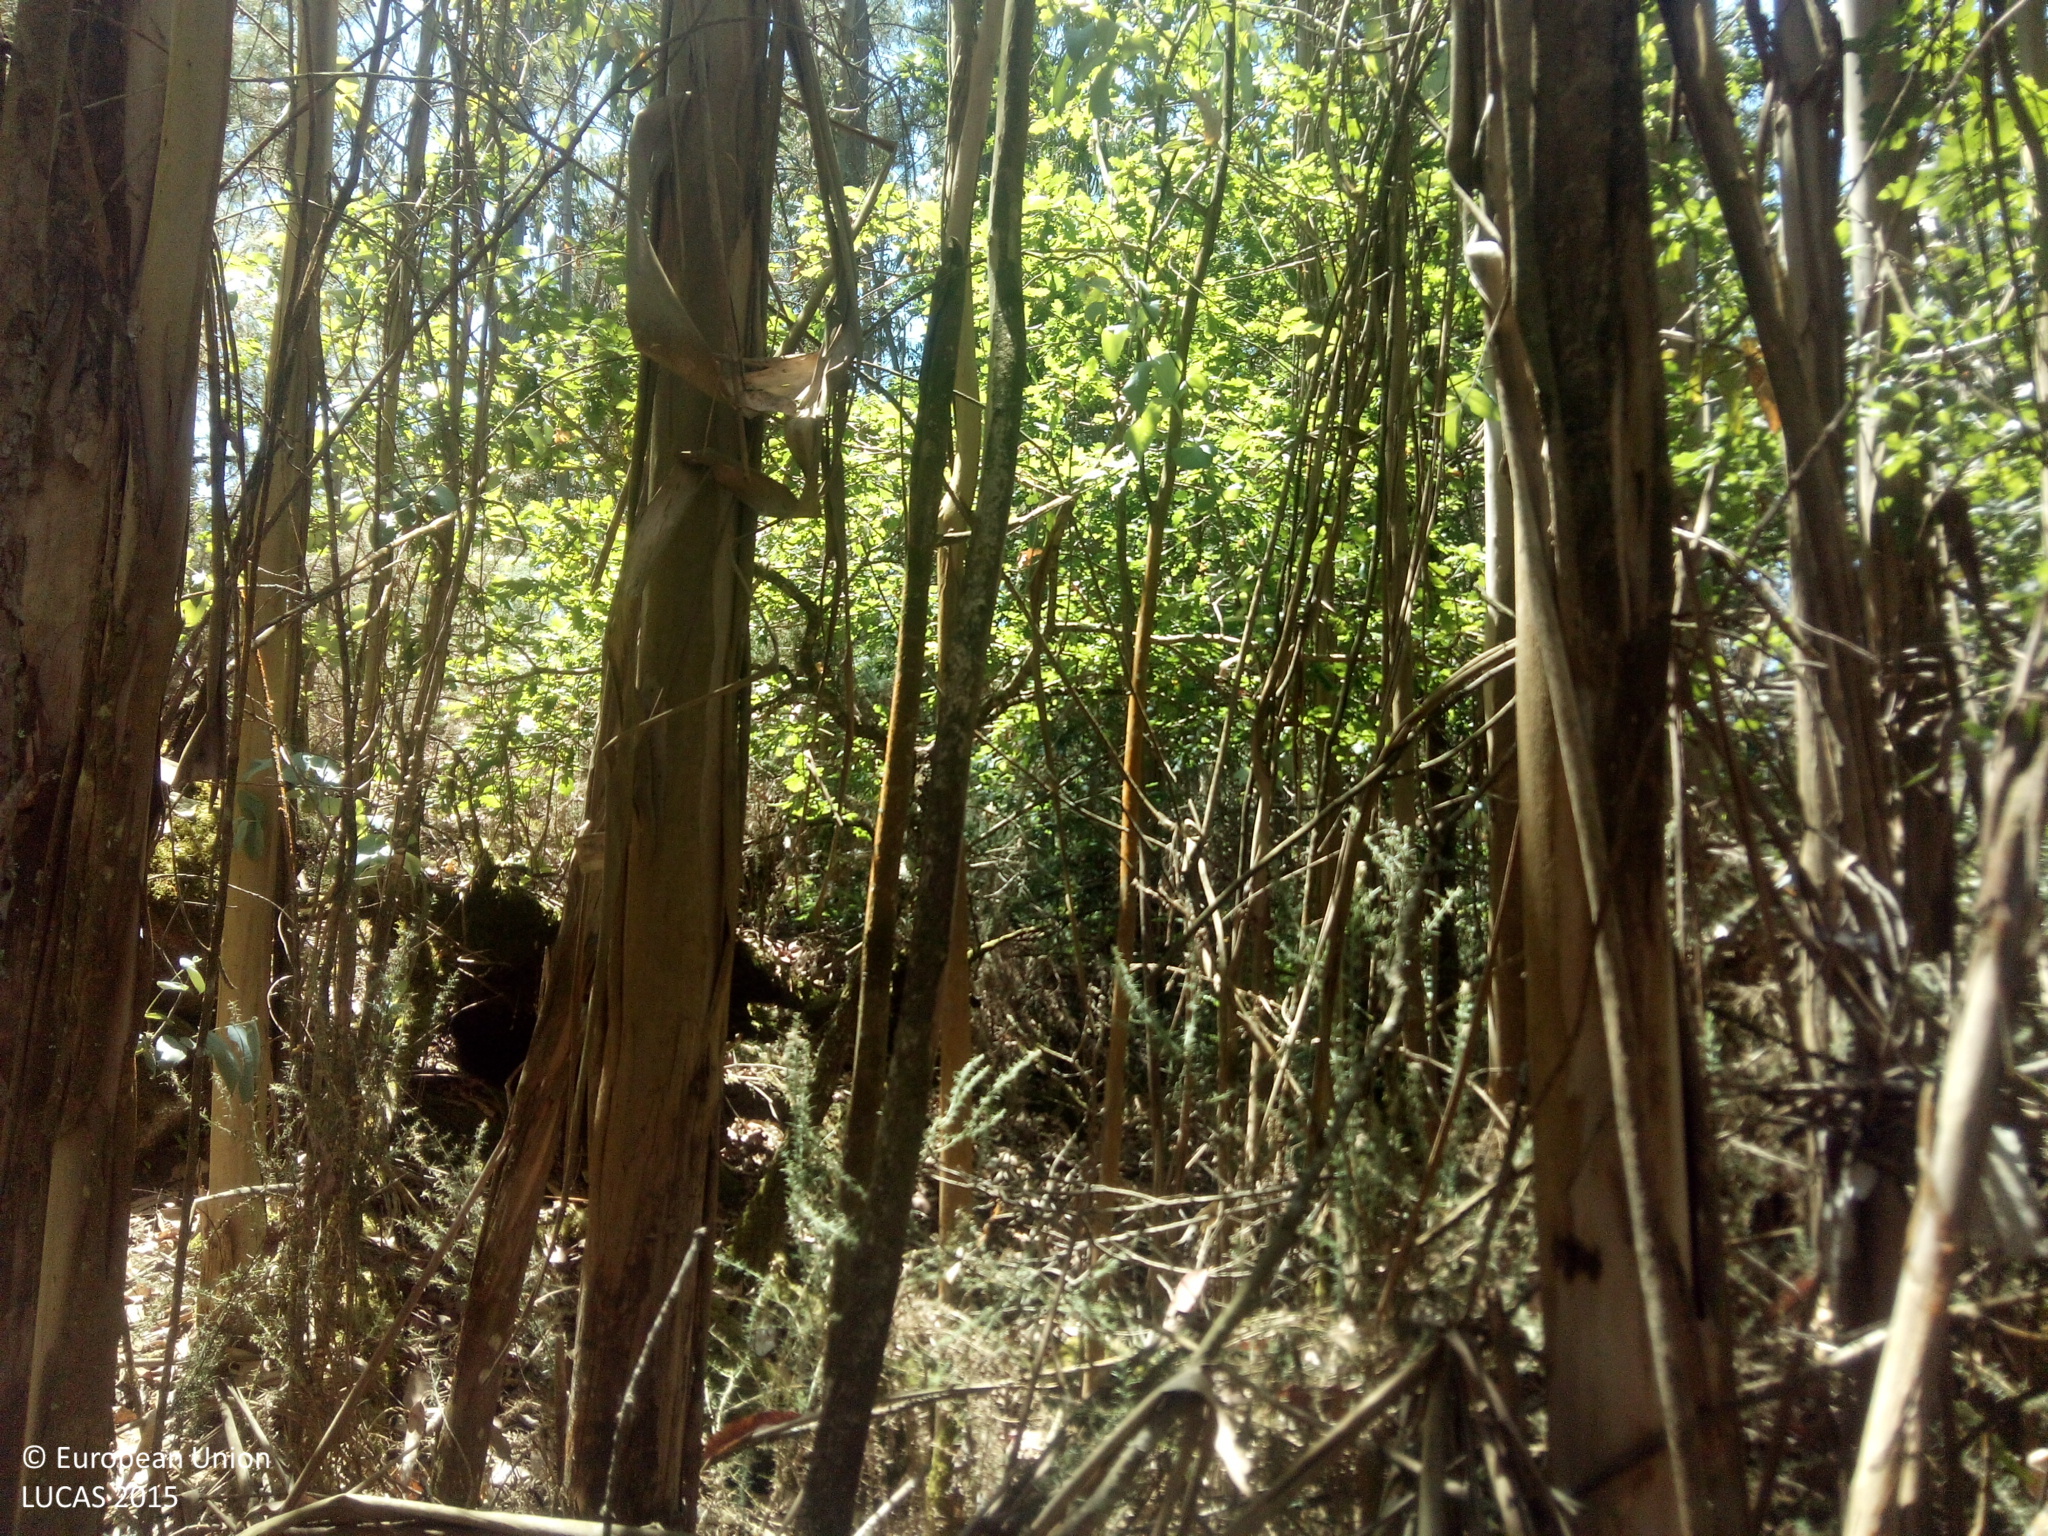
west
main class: Woodland
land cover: Broadleaved woodland
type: exotic forest
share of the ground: > 75 %
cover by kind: broadleaved forest trees 100 %
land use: Forestry
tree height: > 5 m
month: June
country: ES
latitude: 42.7455
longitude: -8.3861
